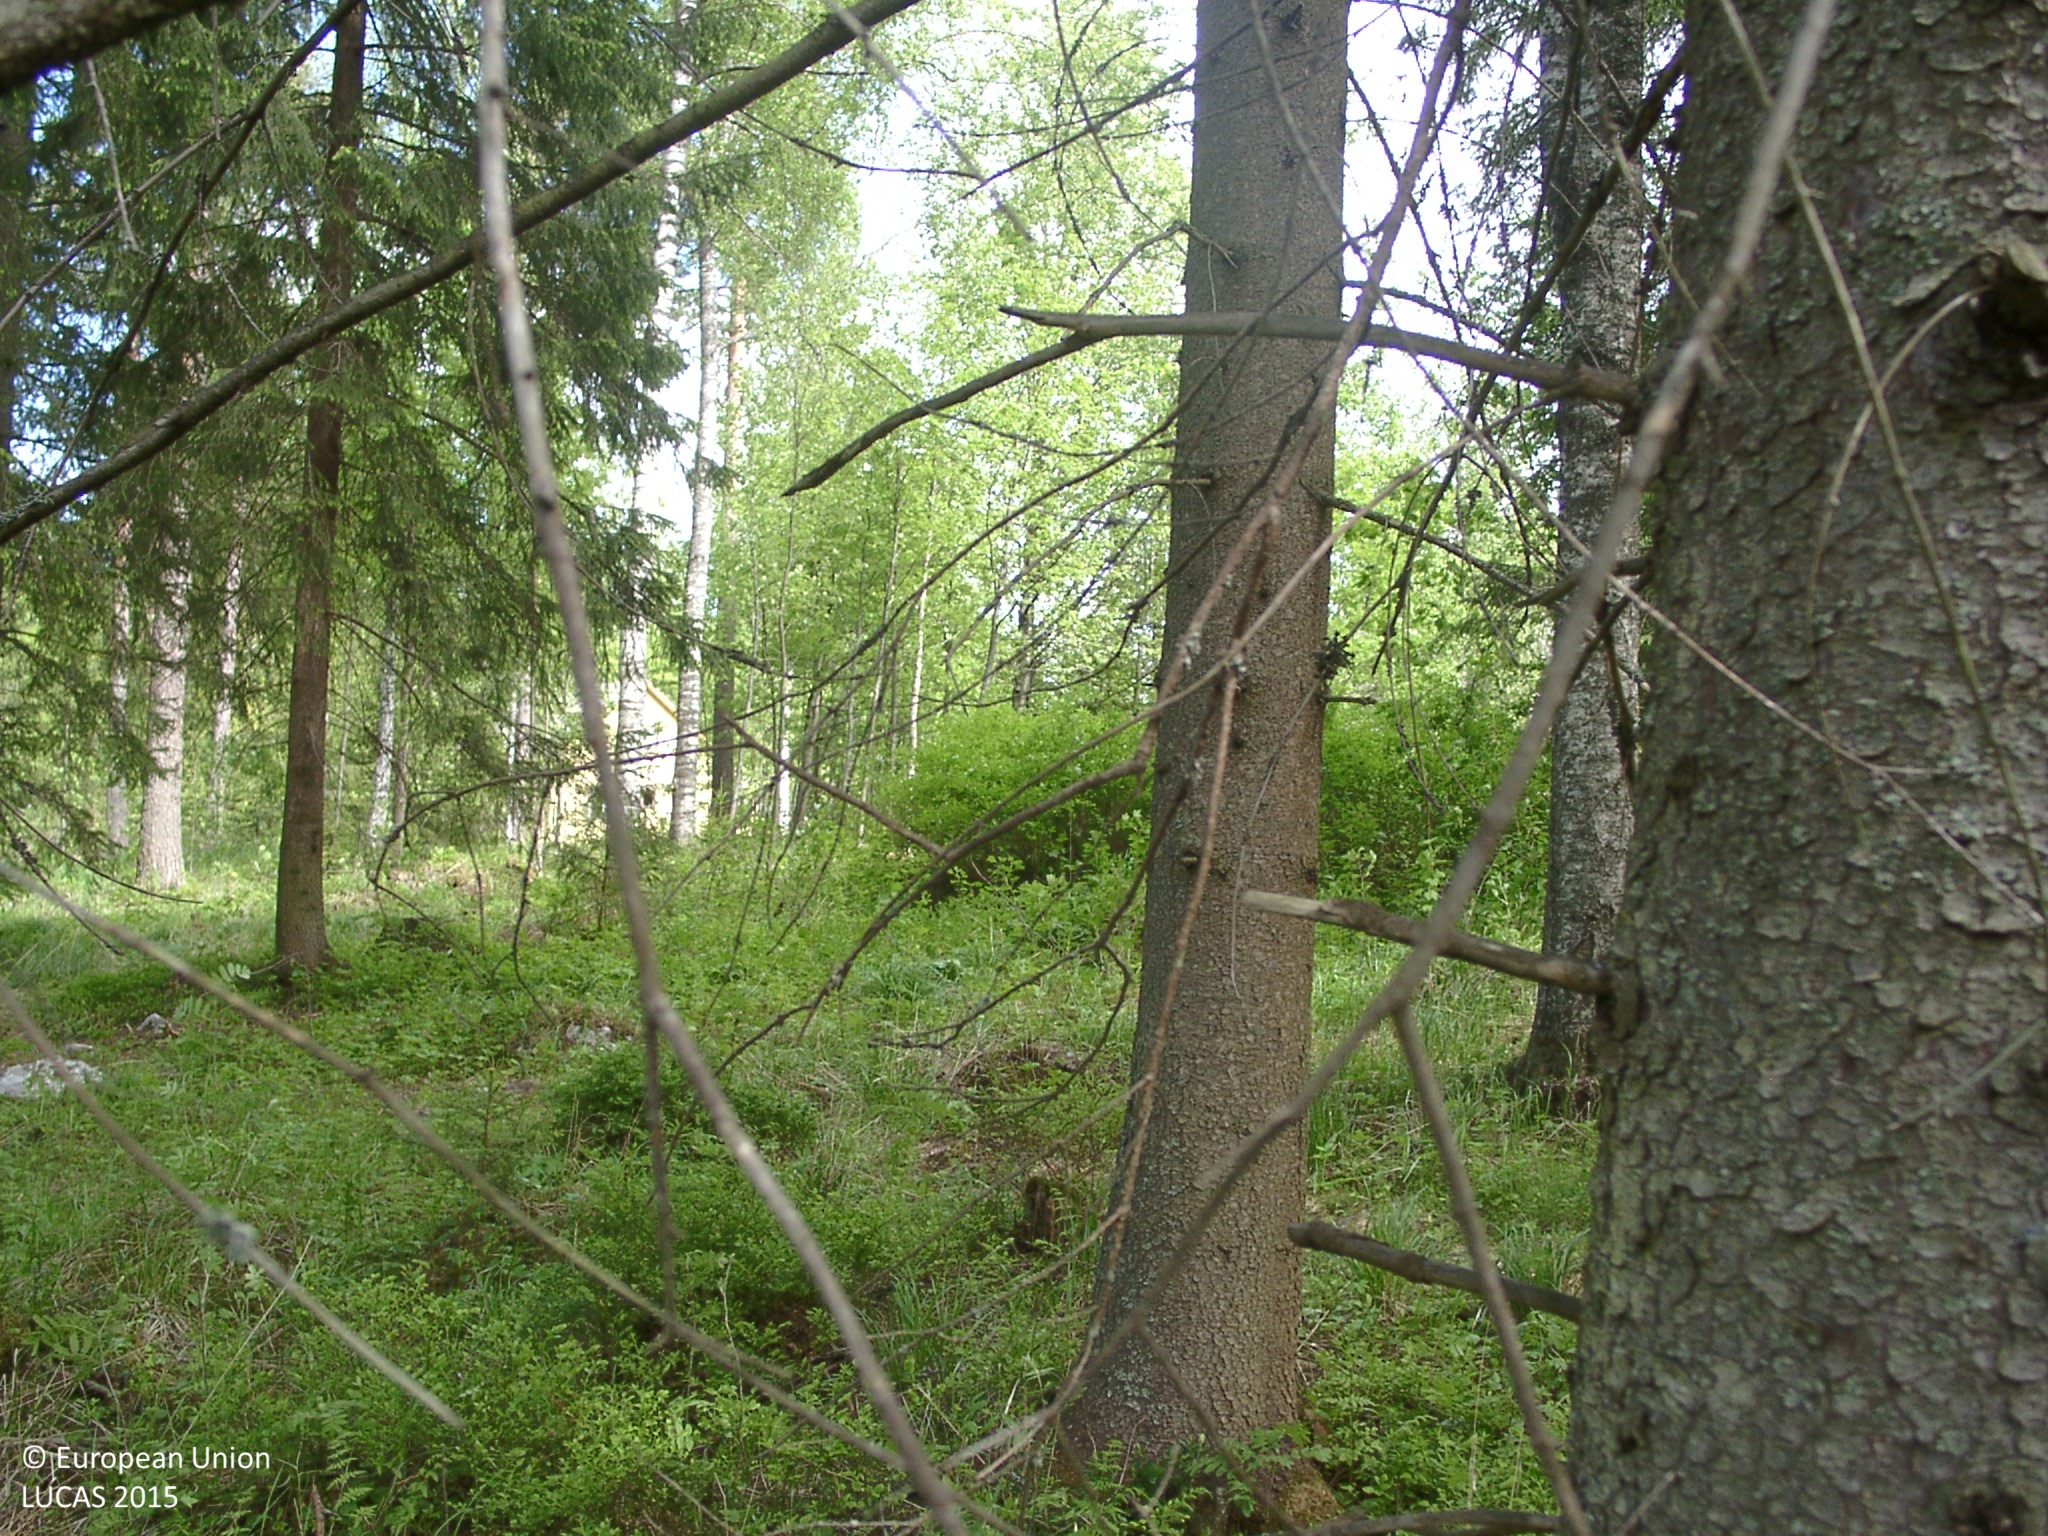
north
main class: Woodland
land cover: Other mixed woodland
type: boreal forest
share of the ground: 50 - 75 %
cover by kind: coniferous forest trees 40 %, broadleaved forest trees 20 %, shrubs 20 %, herbaceous plants 20 %
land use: Amenities, museums, leisure
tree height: > 5 m
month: June
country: FI
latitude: 62.2433
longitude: 25.6900
